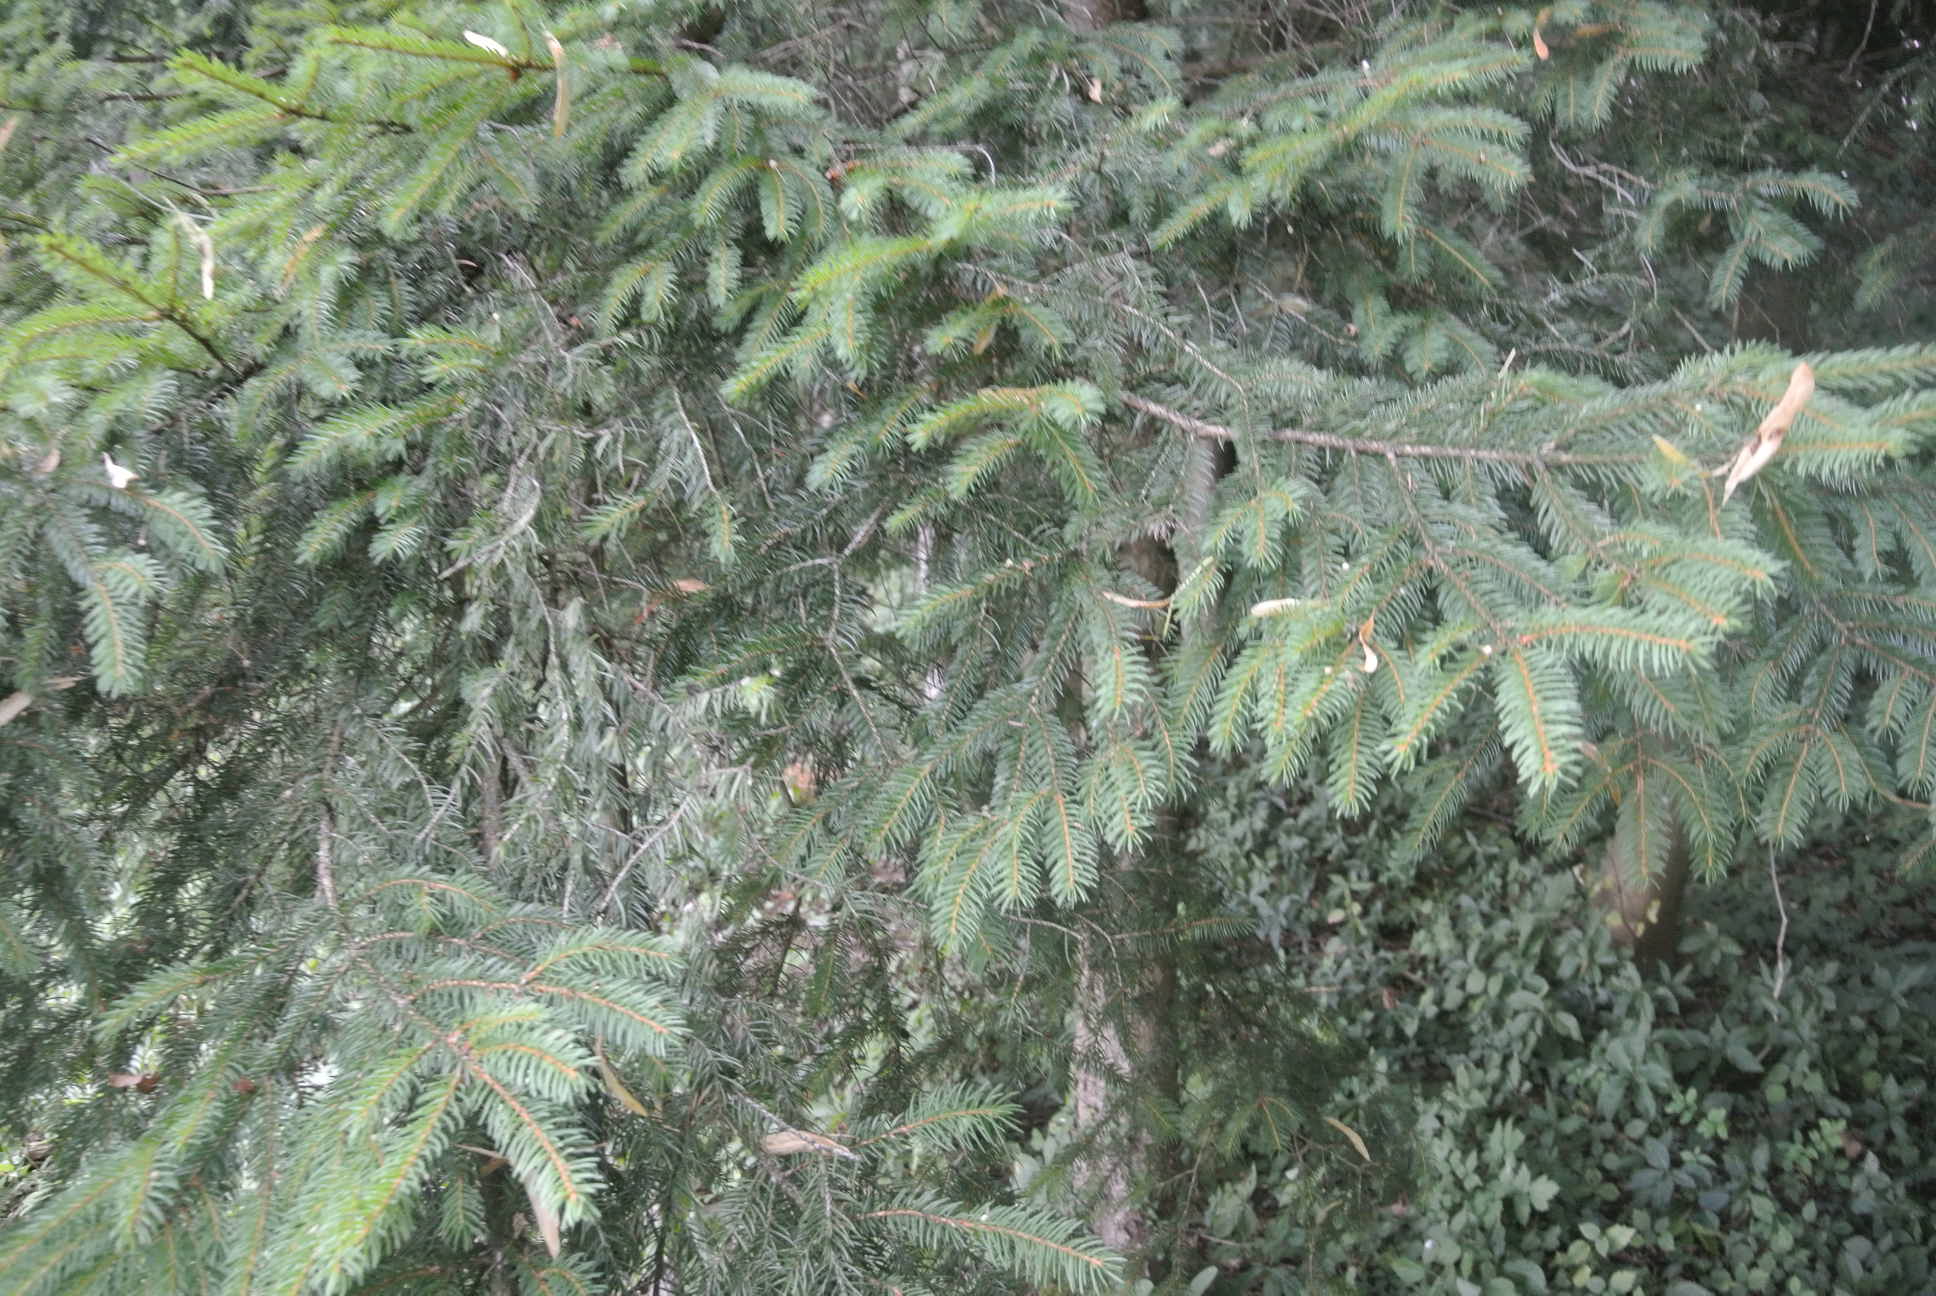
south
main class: Woodland
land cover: Spruce dominated mixed woodland
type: alpine coniferous forest
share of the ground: > 75 %
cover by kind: coniferous forest trees 60 %, broadleaved forest trees 40 %
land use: Forestry
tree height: > 5 m
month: July
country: AT
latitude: 48.0162
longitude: 15.4584
